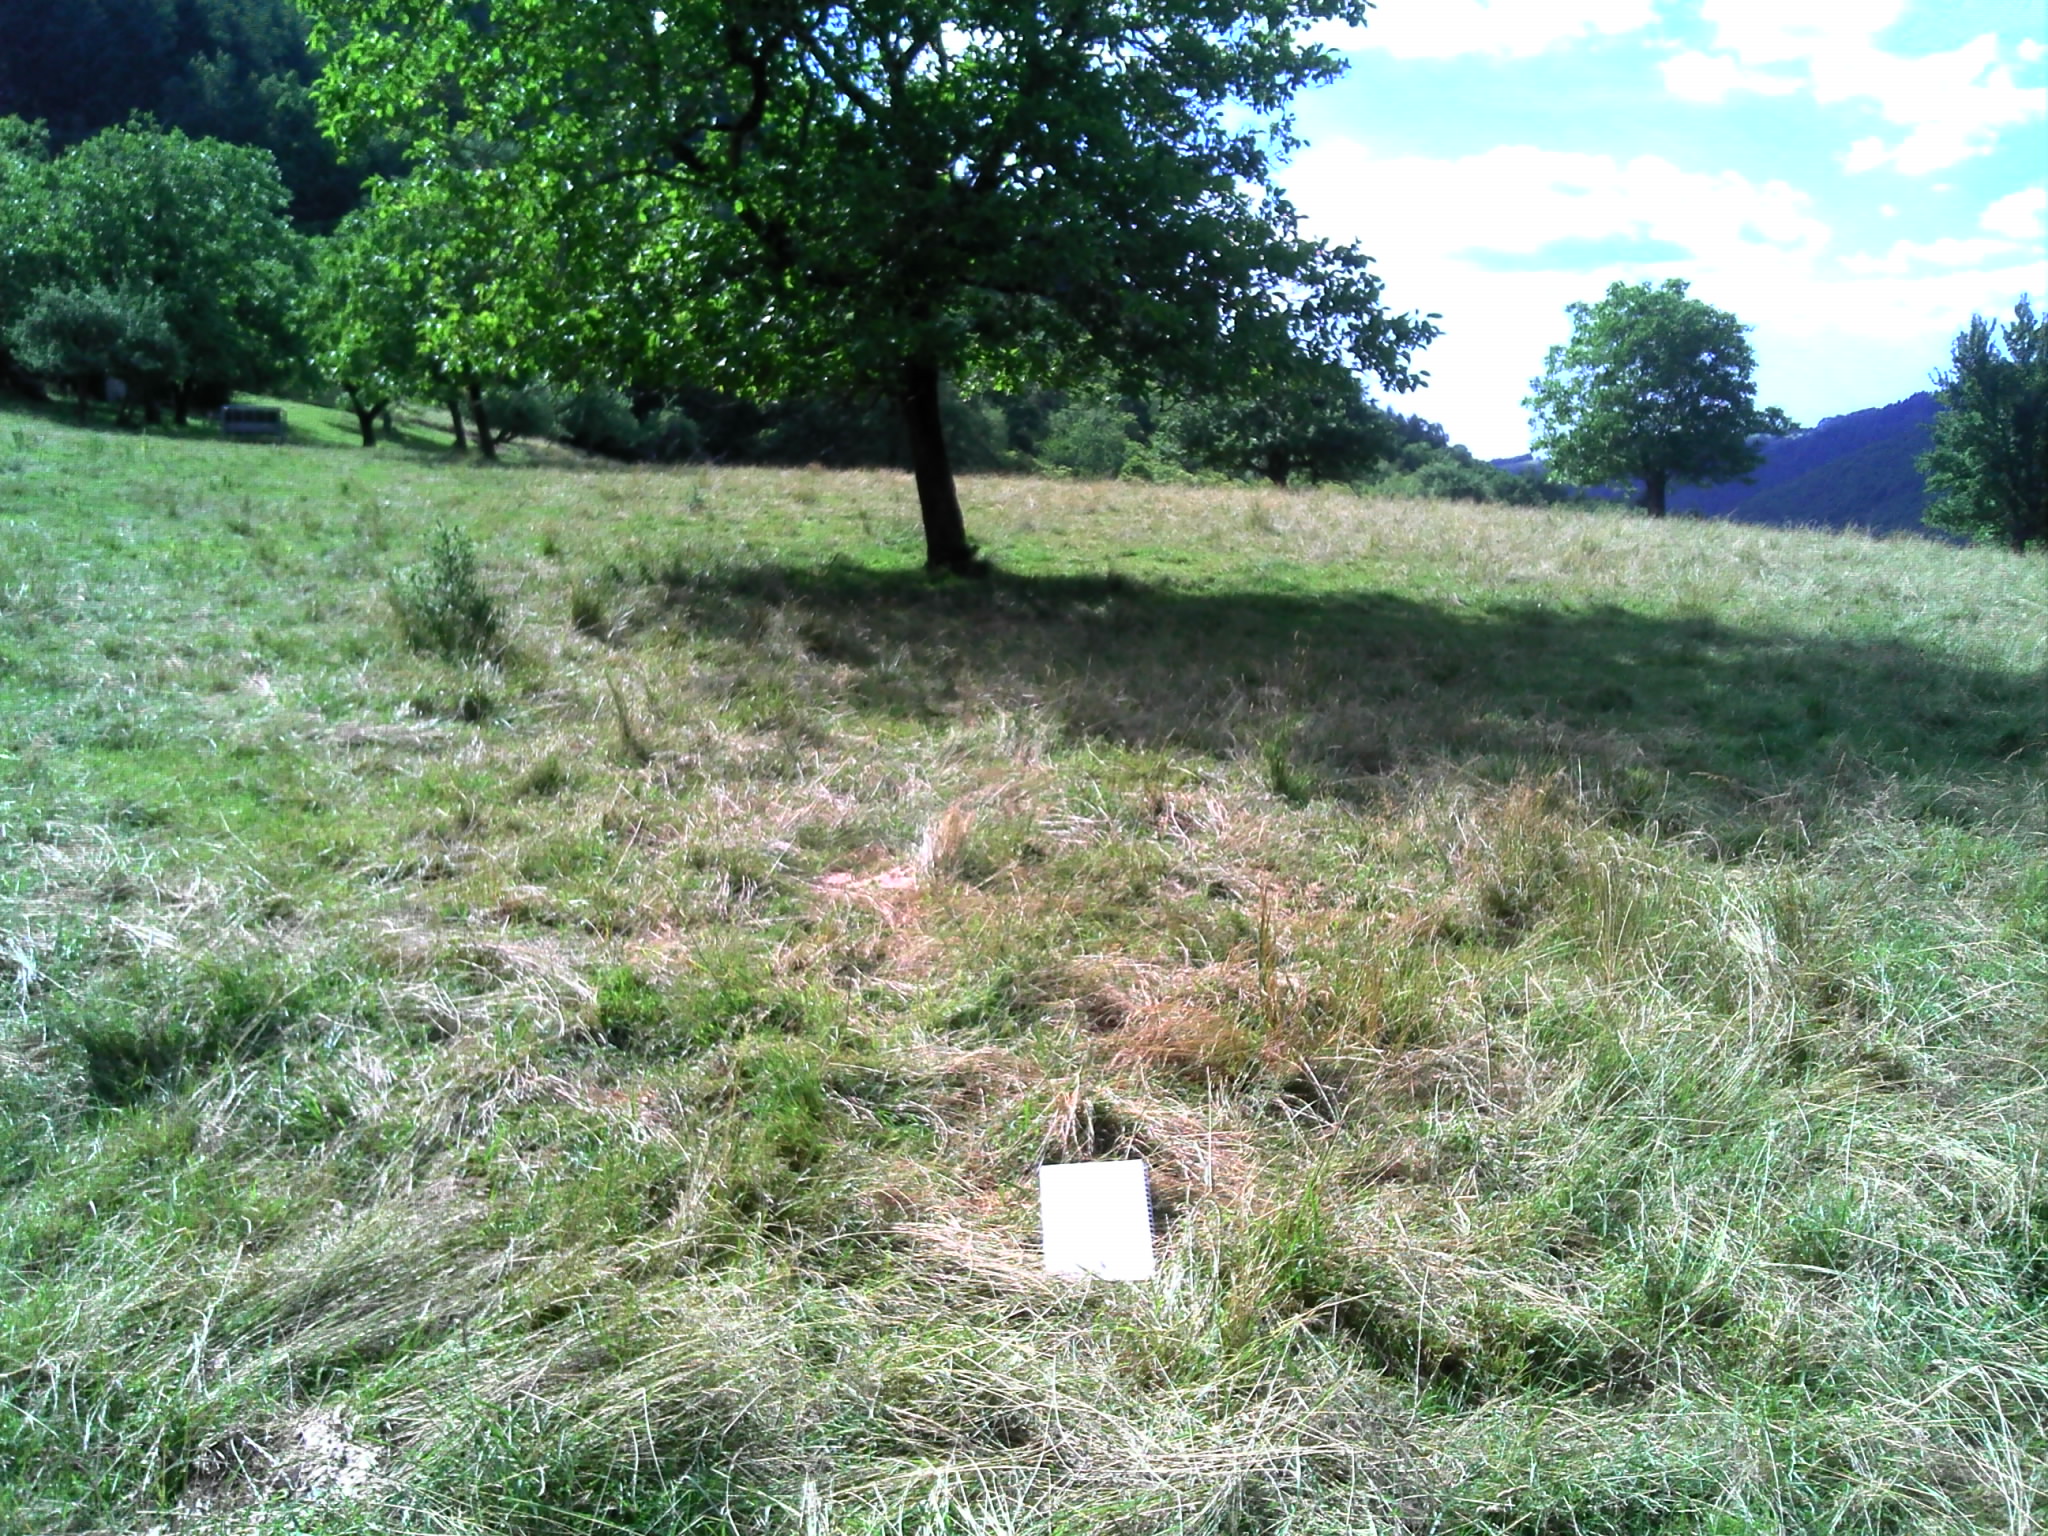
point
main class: Grassland
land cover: Grassland with sparse tree/shrub cover
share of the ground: > 75 %
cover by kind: herbaceous plants 95 %, broadleaved forest trees 5 %
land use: Agriculture (excluding fallow land and kitchen gardens)
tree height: > 5 m
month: June
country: FR
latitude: 44.8895
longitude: 1.9585
